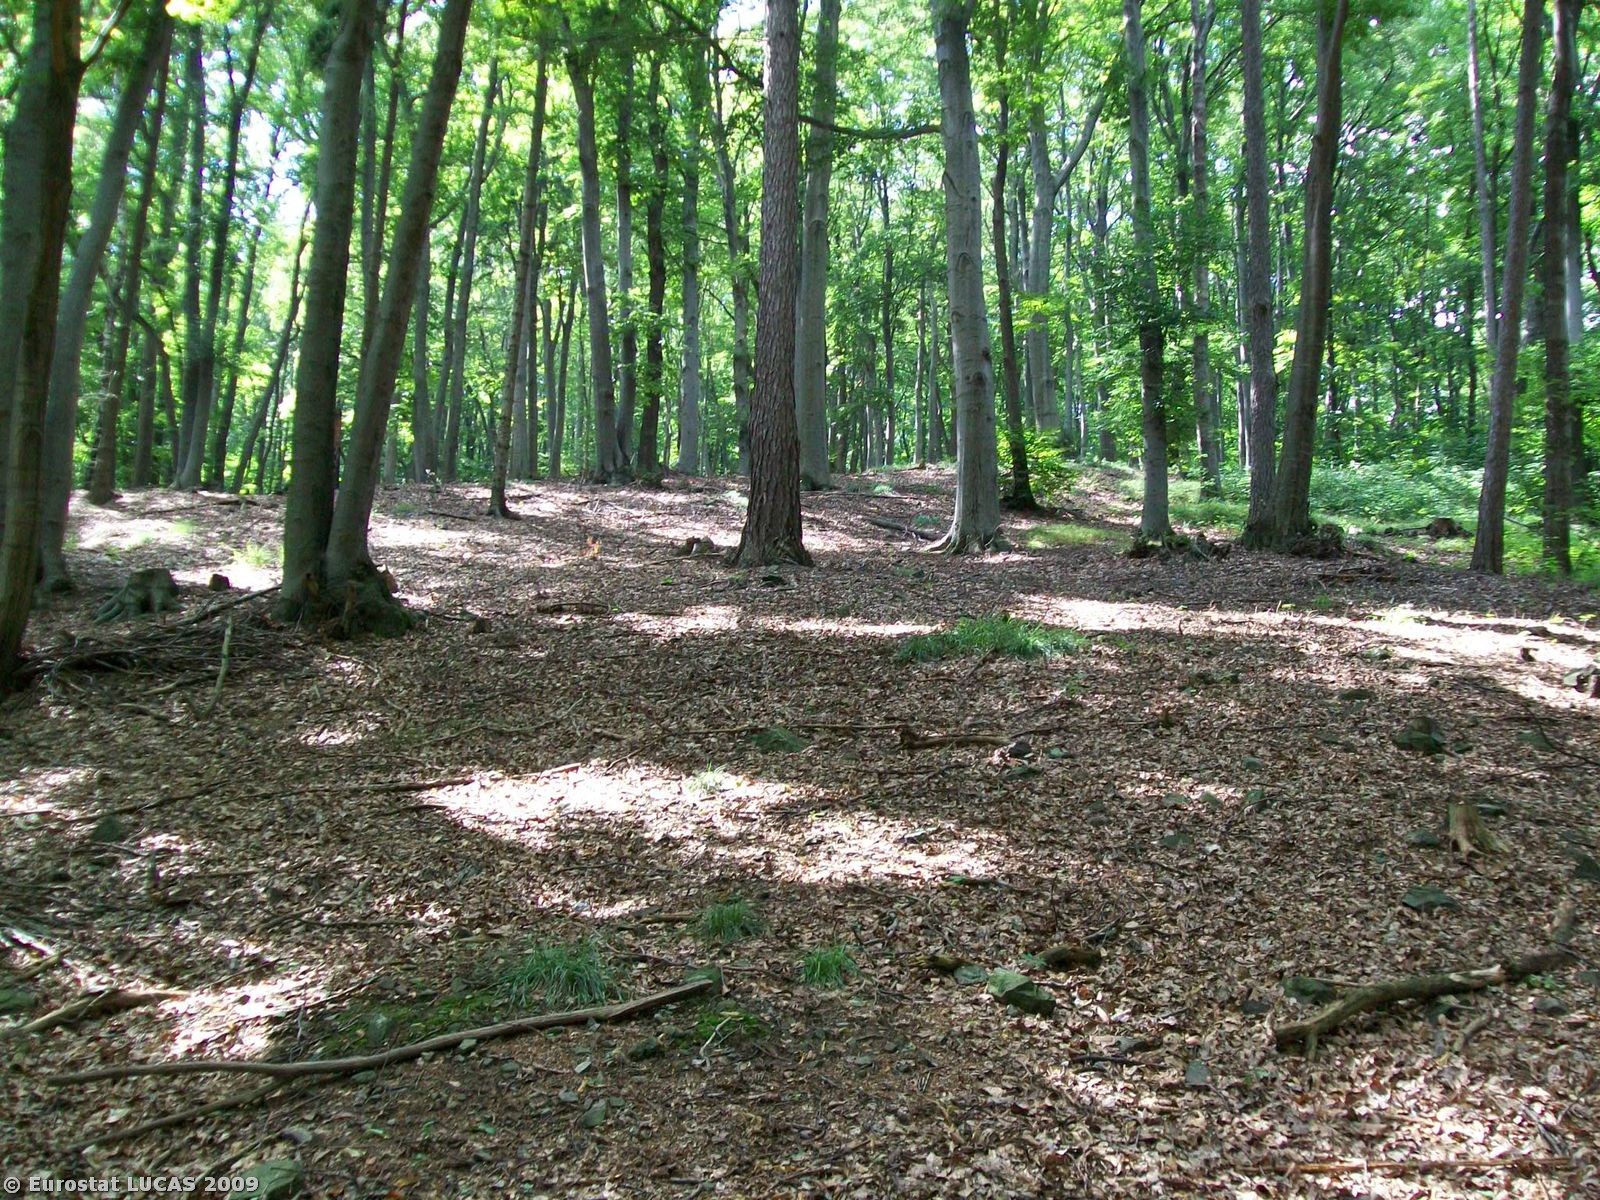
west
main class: Woodland
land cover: Broadleaved woodland
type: beech forest
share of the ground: > 75 %
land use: Amenities, museums, leisure
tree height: > 5 m
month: August
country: PL
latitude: 50.8874
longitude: 16.7326
